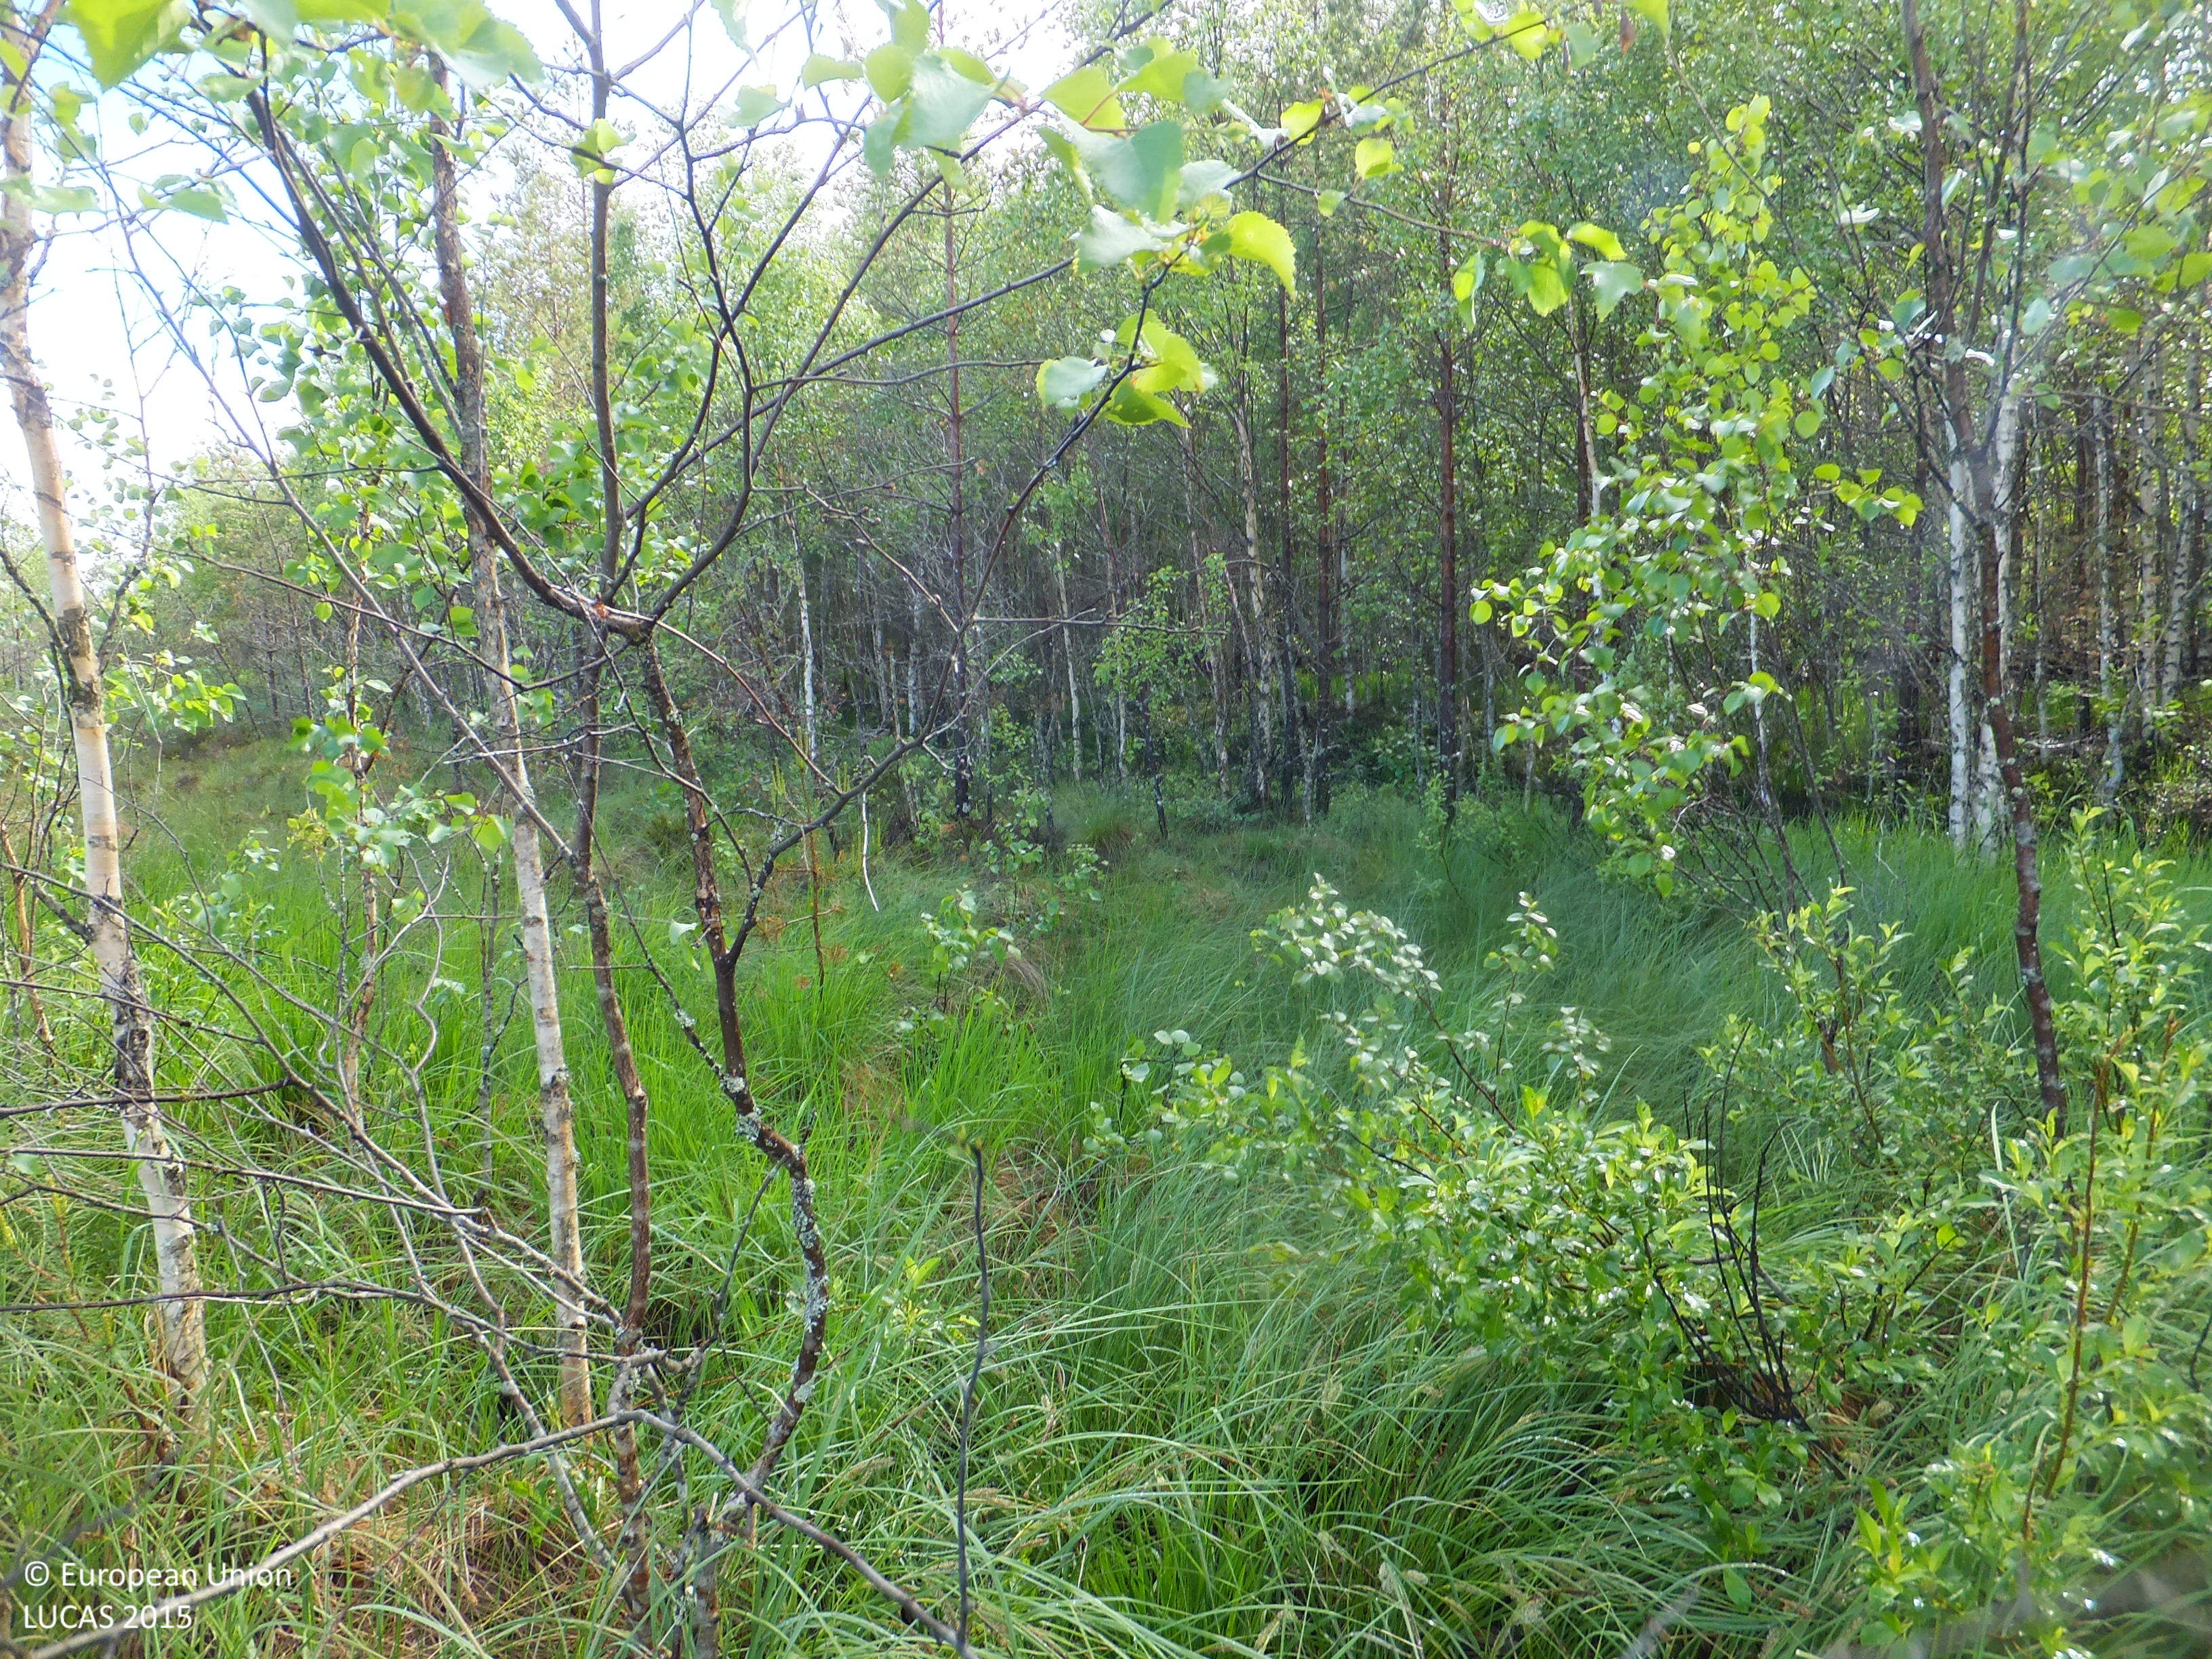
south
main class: Woodland
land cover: Broadleaved woodland
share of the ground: 25 - 50 %
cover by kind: broadleaved forest trees 30 %, herbaceous plants 30 %, shrubs 20 %, lichens and mosses 10 %
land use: Semi-natural and natural areas not in use
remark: Temporary flooded
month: June
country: FI
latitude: 63.4325
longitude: 24.6941
